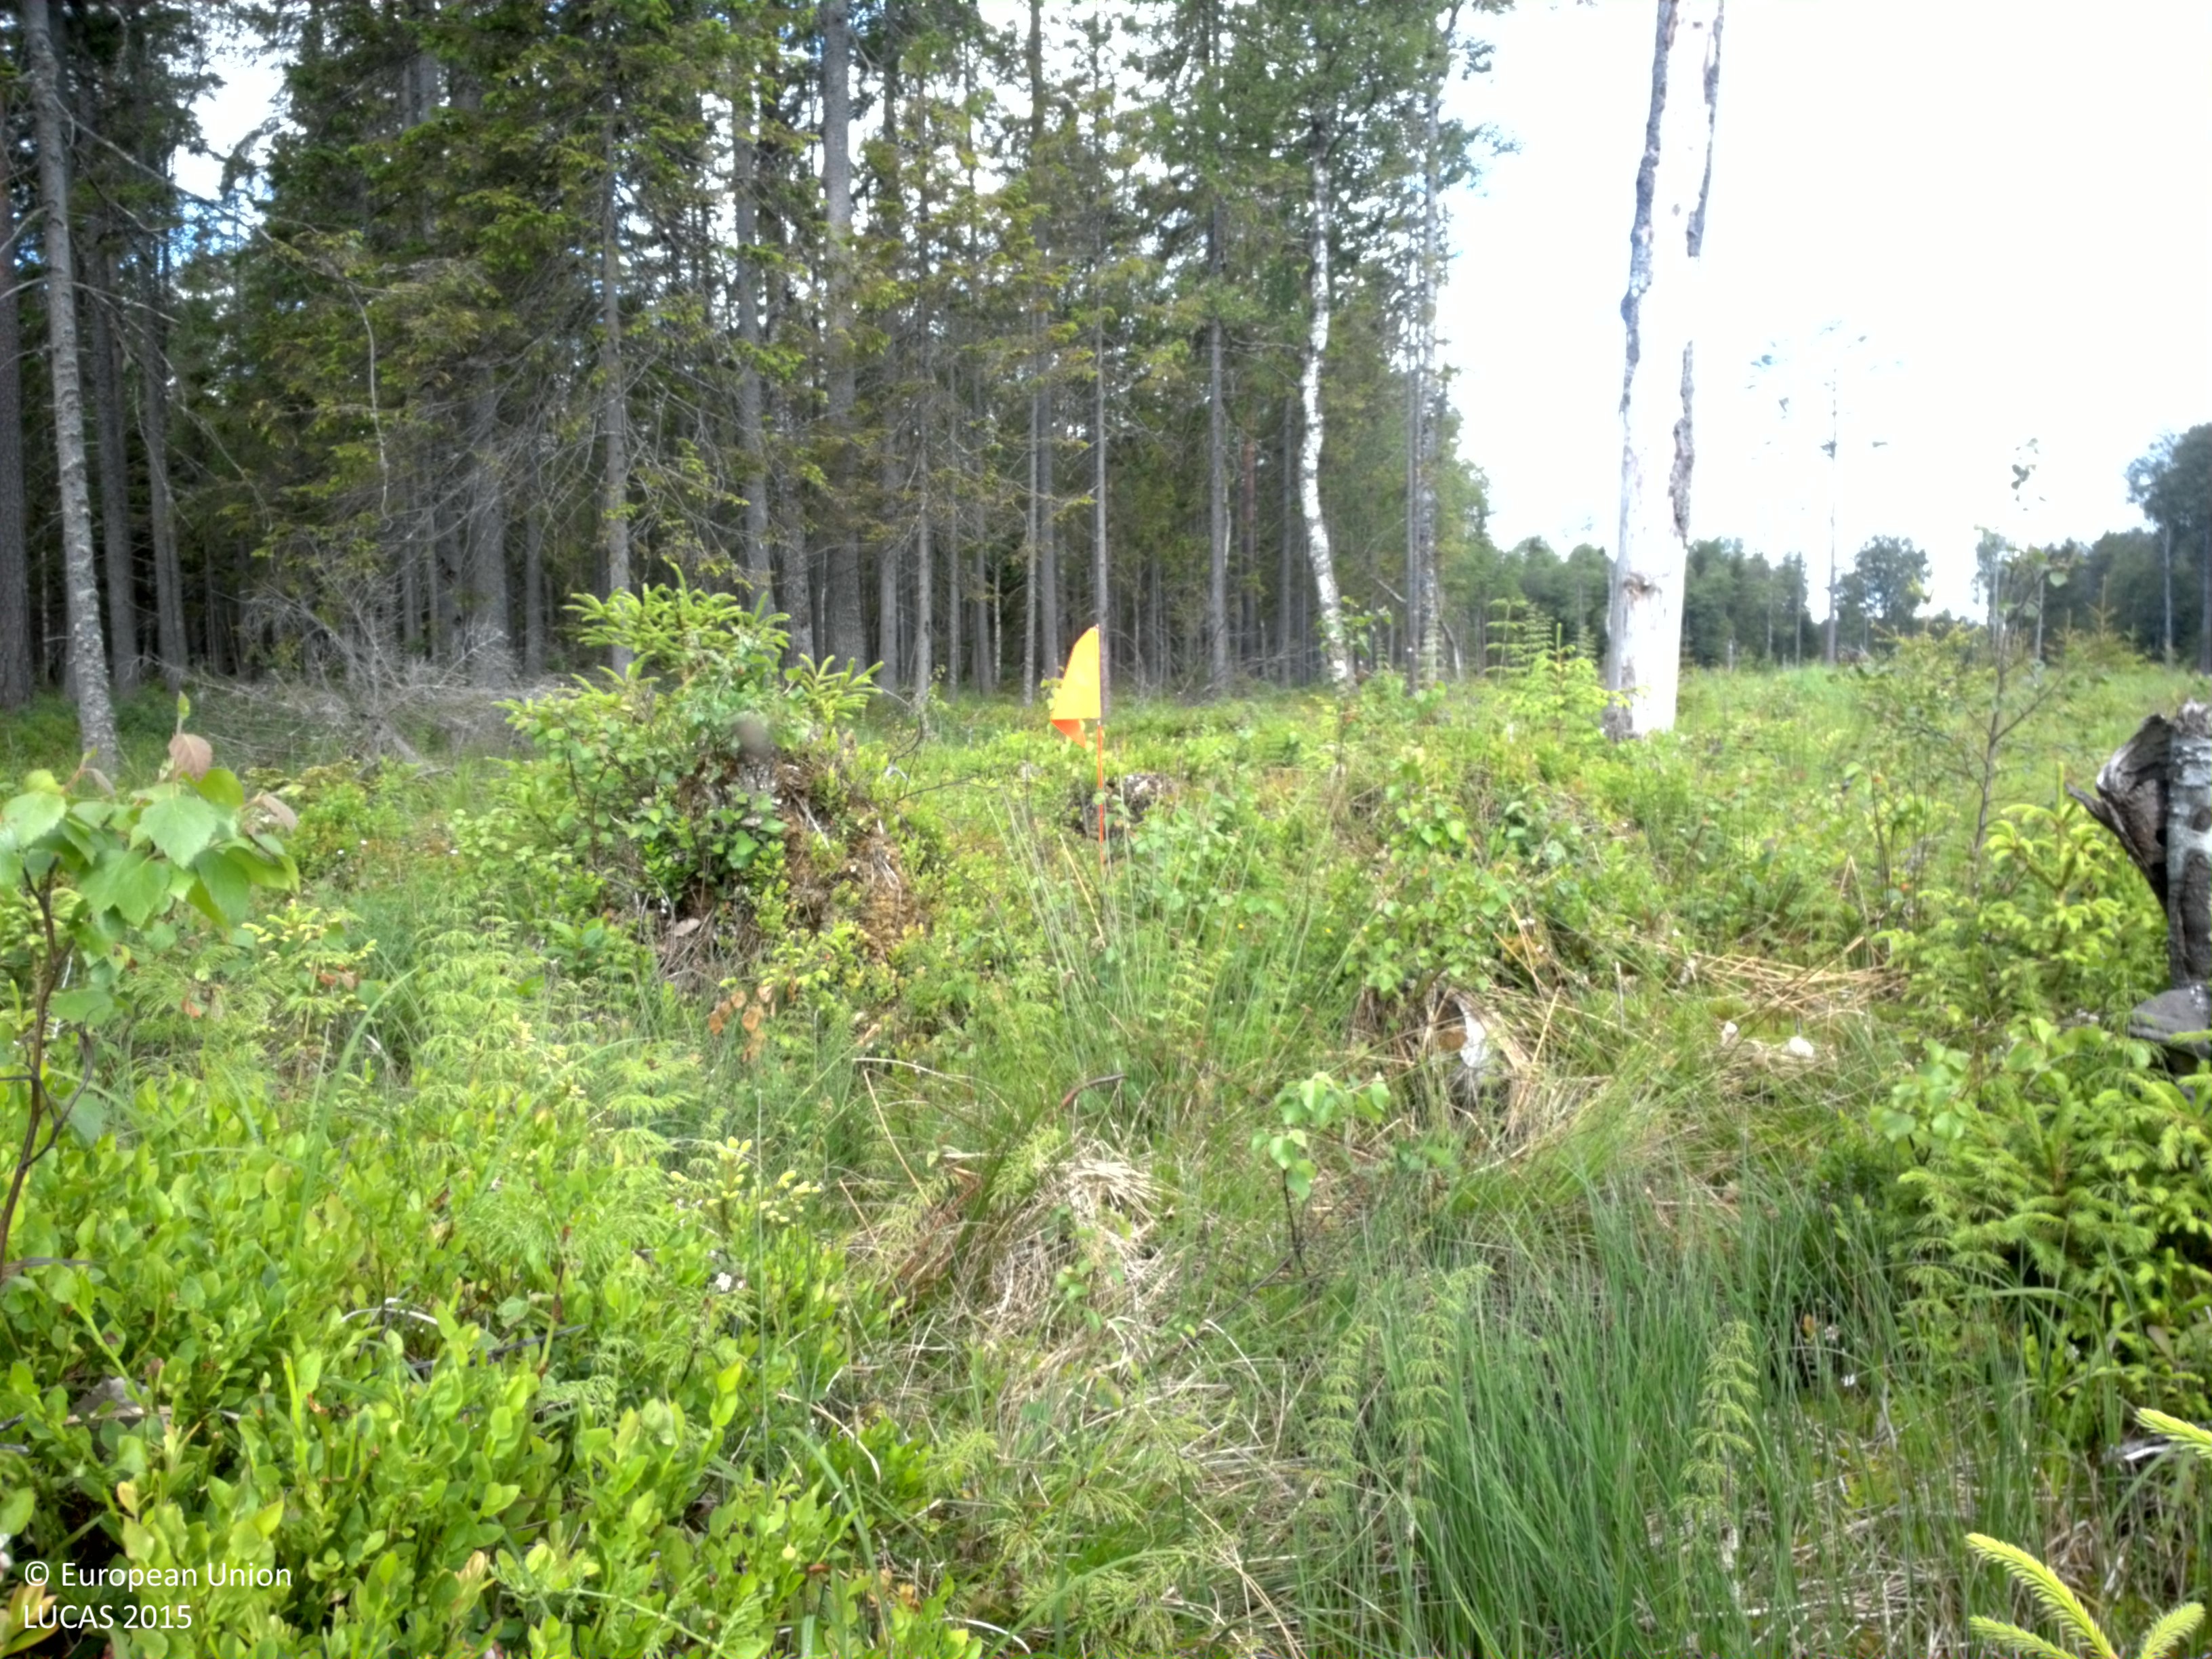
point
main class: Woodland
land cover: Spruce dominated mixed woodland
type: boreal forest
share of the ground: 10 - 25 %
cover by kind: herbaceous plants 40 %, lichens and mosses 40 %, coniferous forest trees 15 %, broadleaved forest trees 5 %
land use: Forestry
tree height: < 5 m
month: June
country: SE
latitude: 59.9261
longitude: 17.1665
